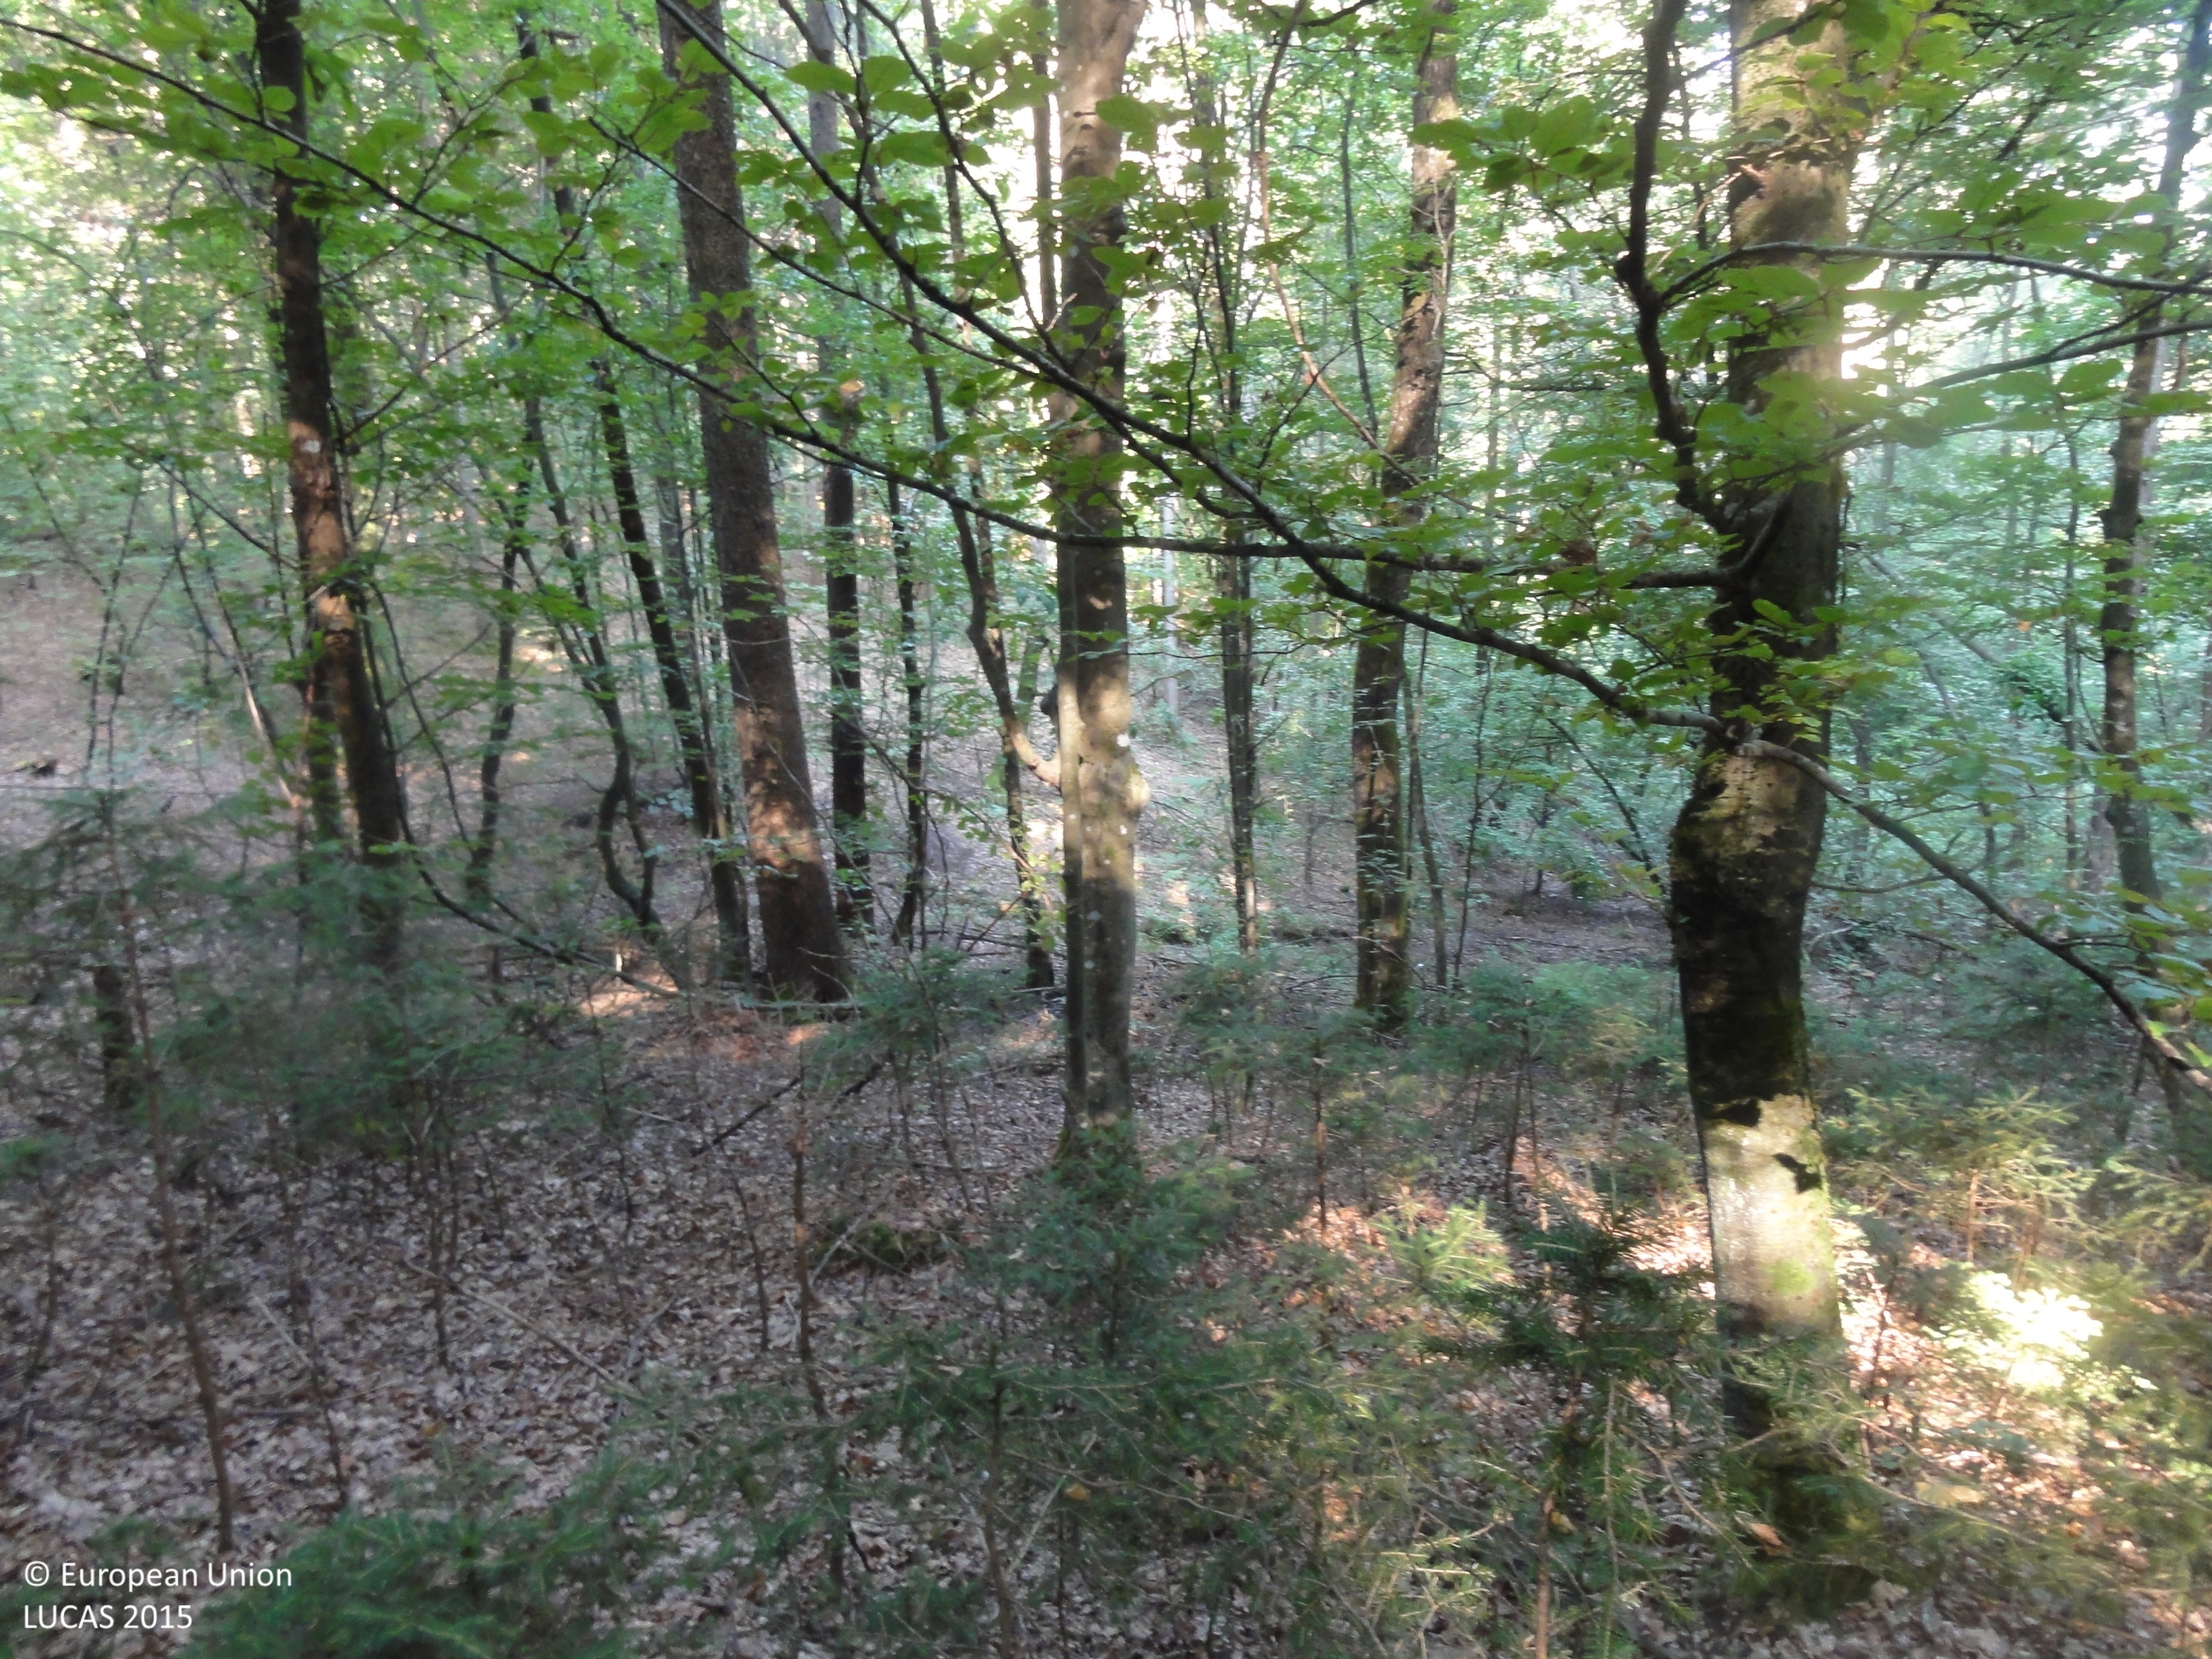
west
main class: Woodland
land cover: Spruce dominated mixed woodland
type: mountainous beech forest
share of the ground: > 75 %
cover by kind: broadleaved forest trees 60 %, coniferous forest trees 40 %
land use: Forestry
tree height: > 5 m
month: August
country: SI
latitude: 45.9269
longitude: 15.0130
